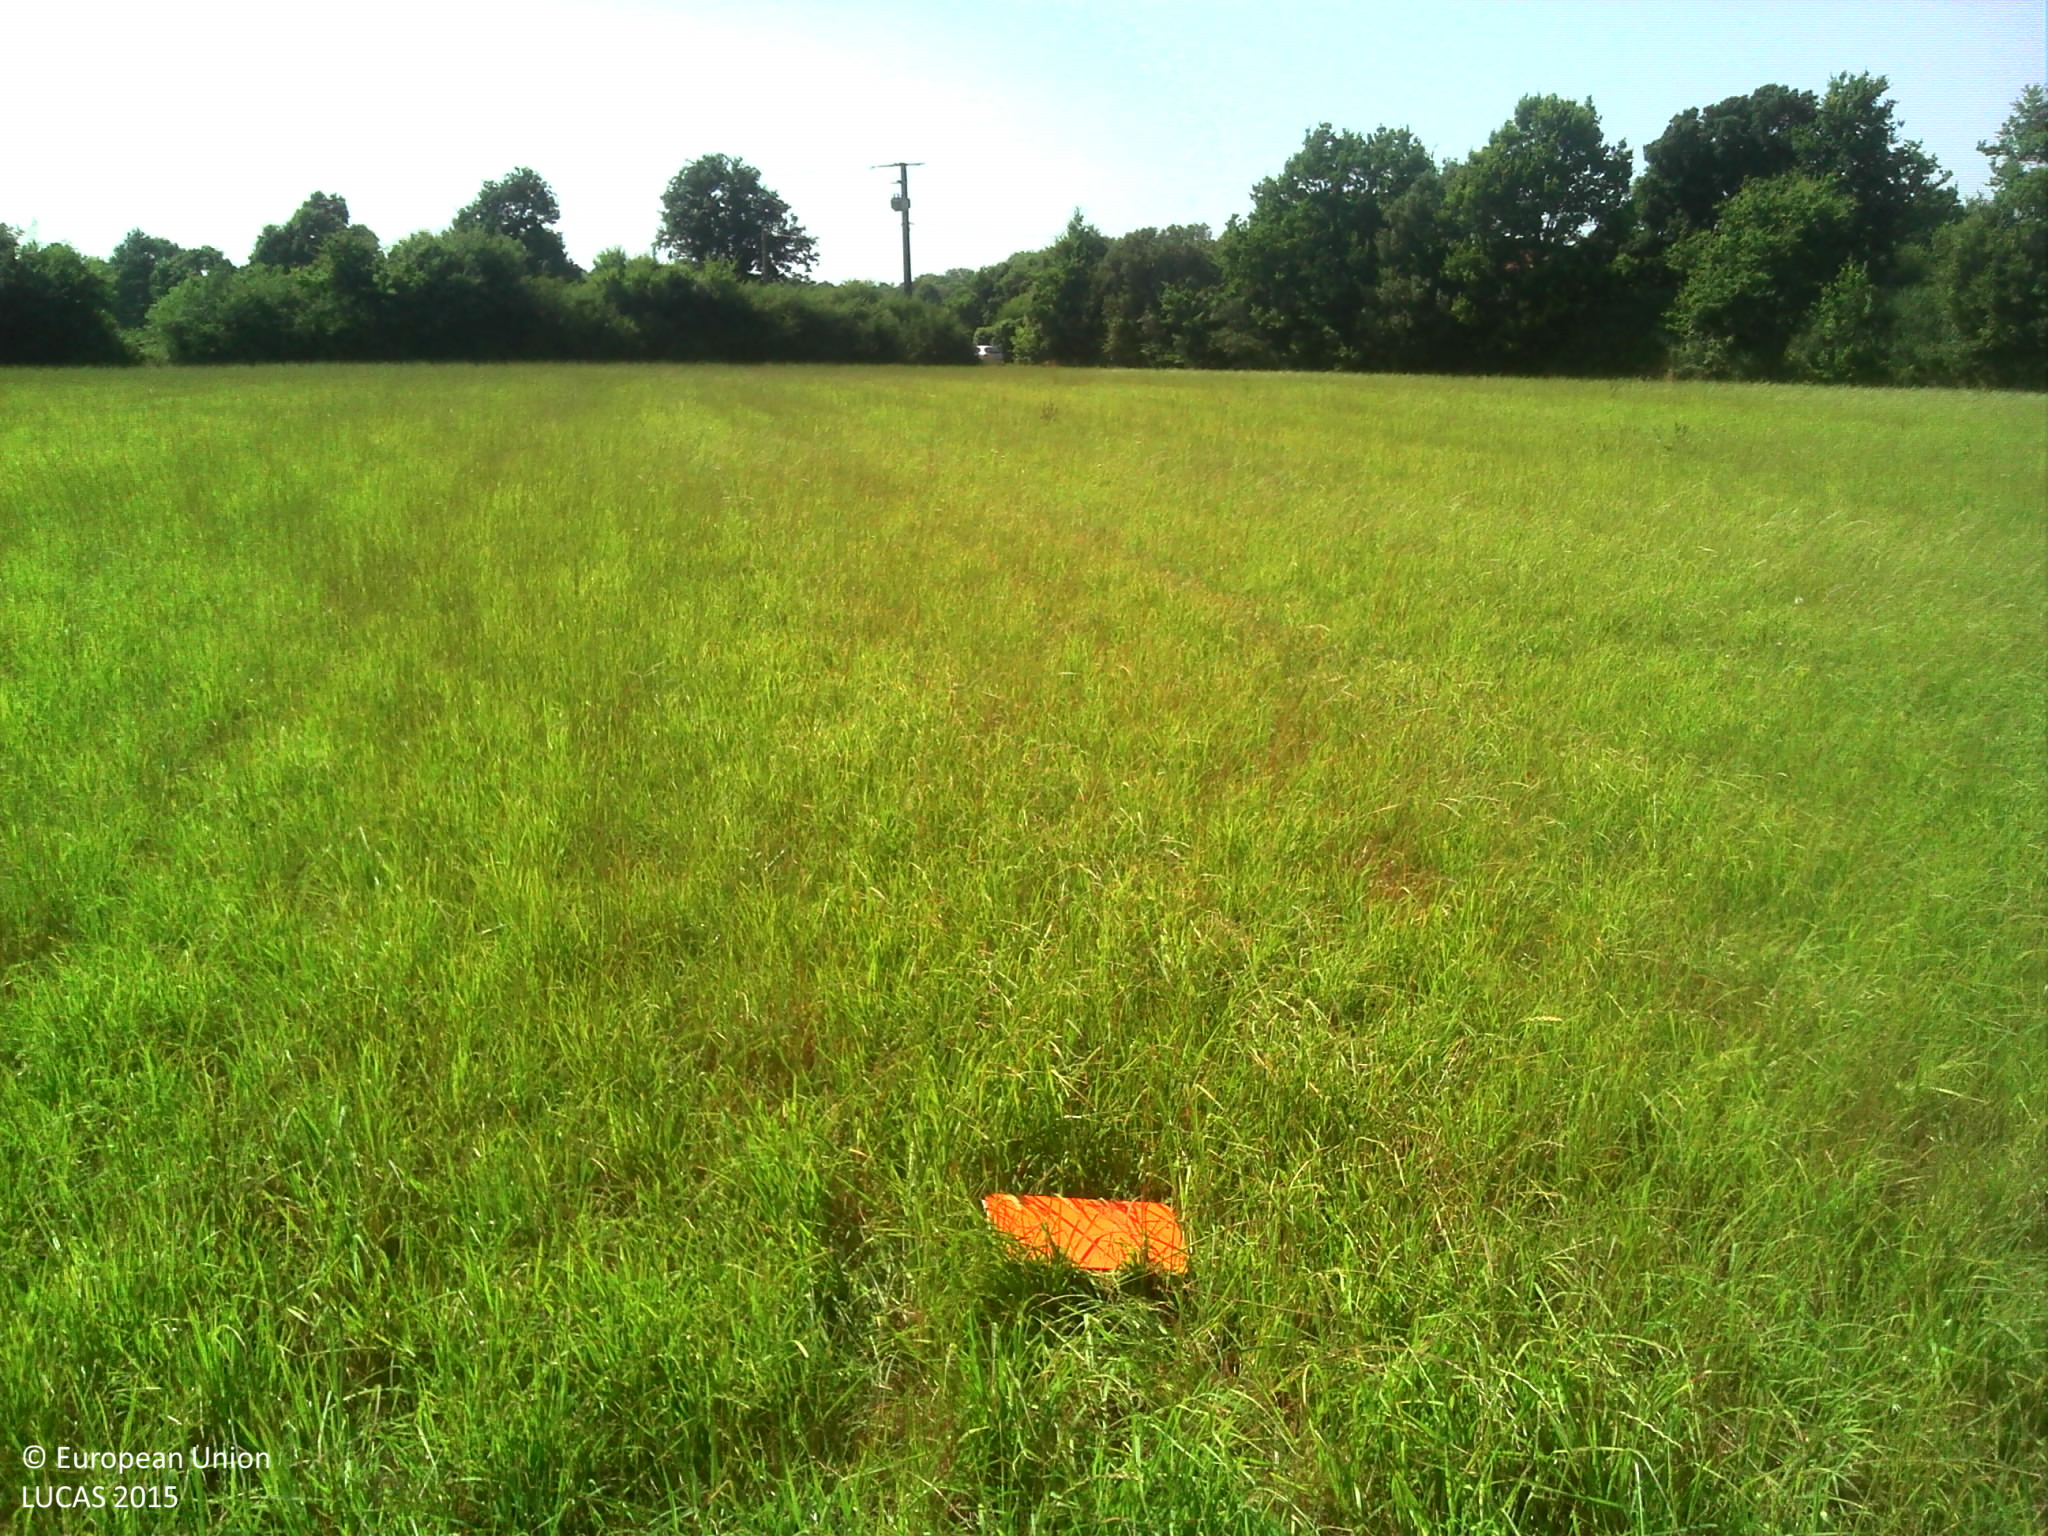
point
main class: Cropland
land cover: Temporary grasslands
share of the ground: > 75 %
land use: Agriculture (excluding fallow land and kitchen gardens)
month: July
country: FR
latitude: 46.5450
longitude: -1.6860
